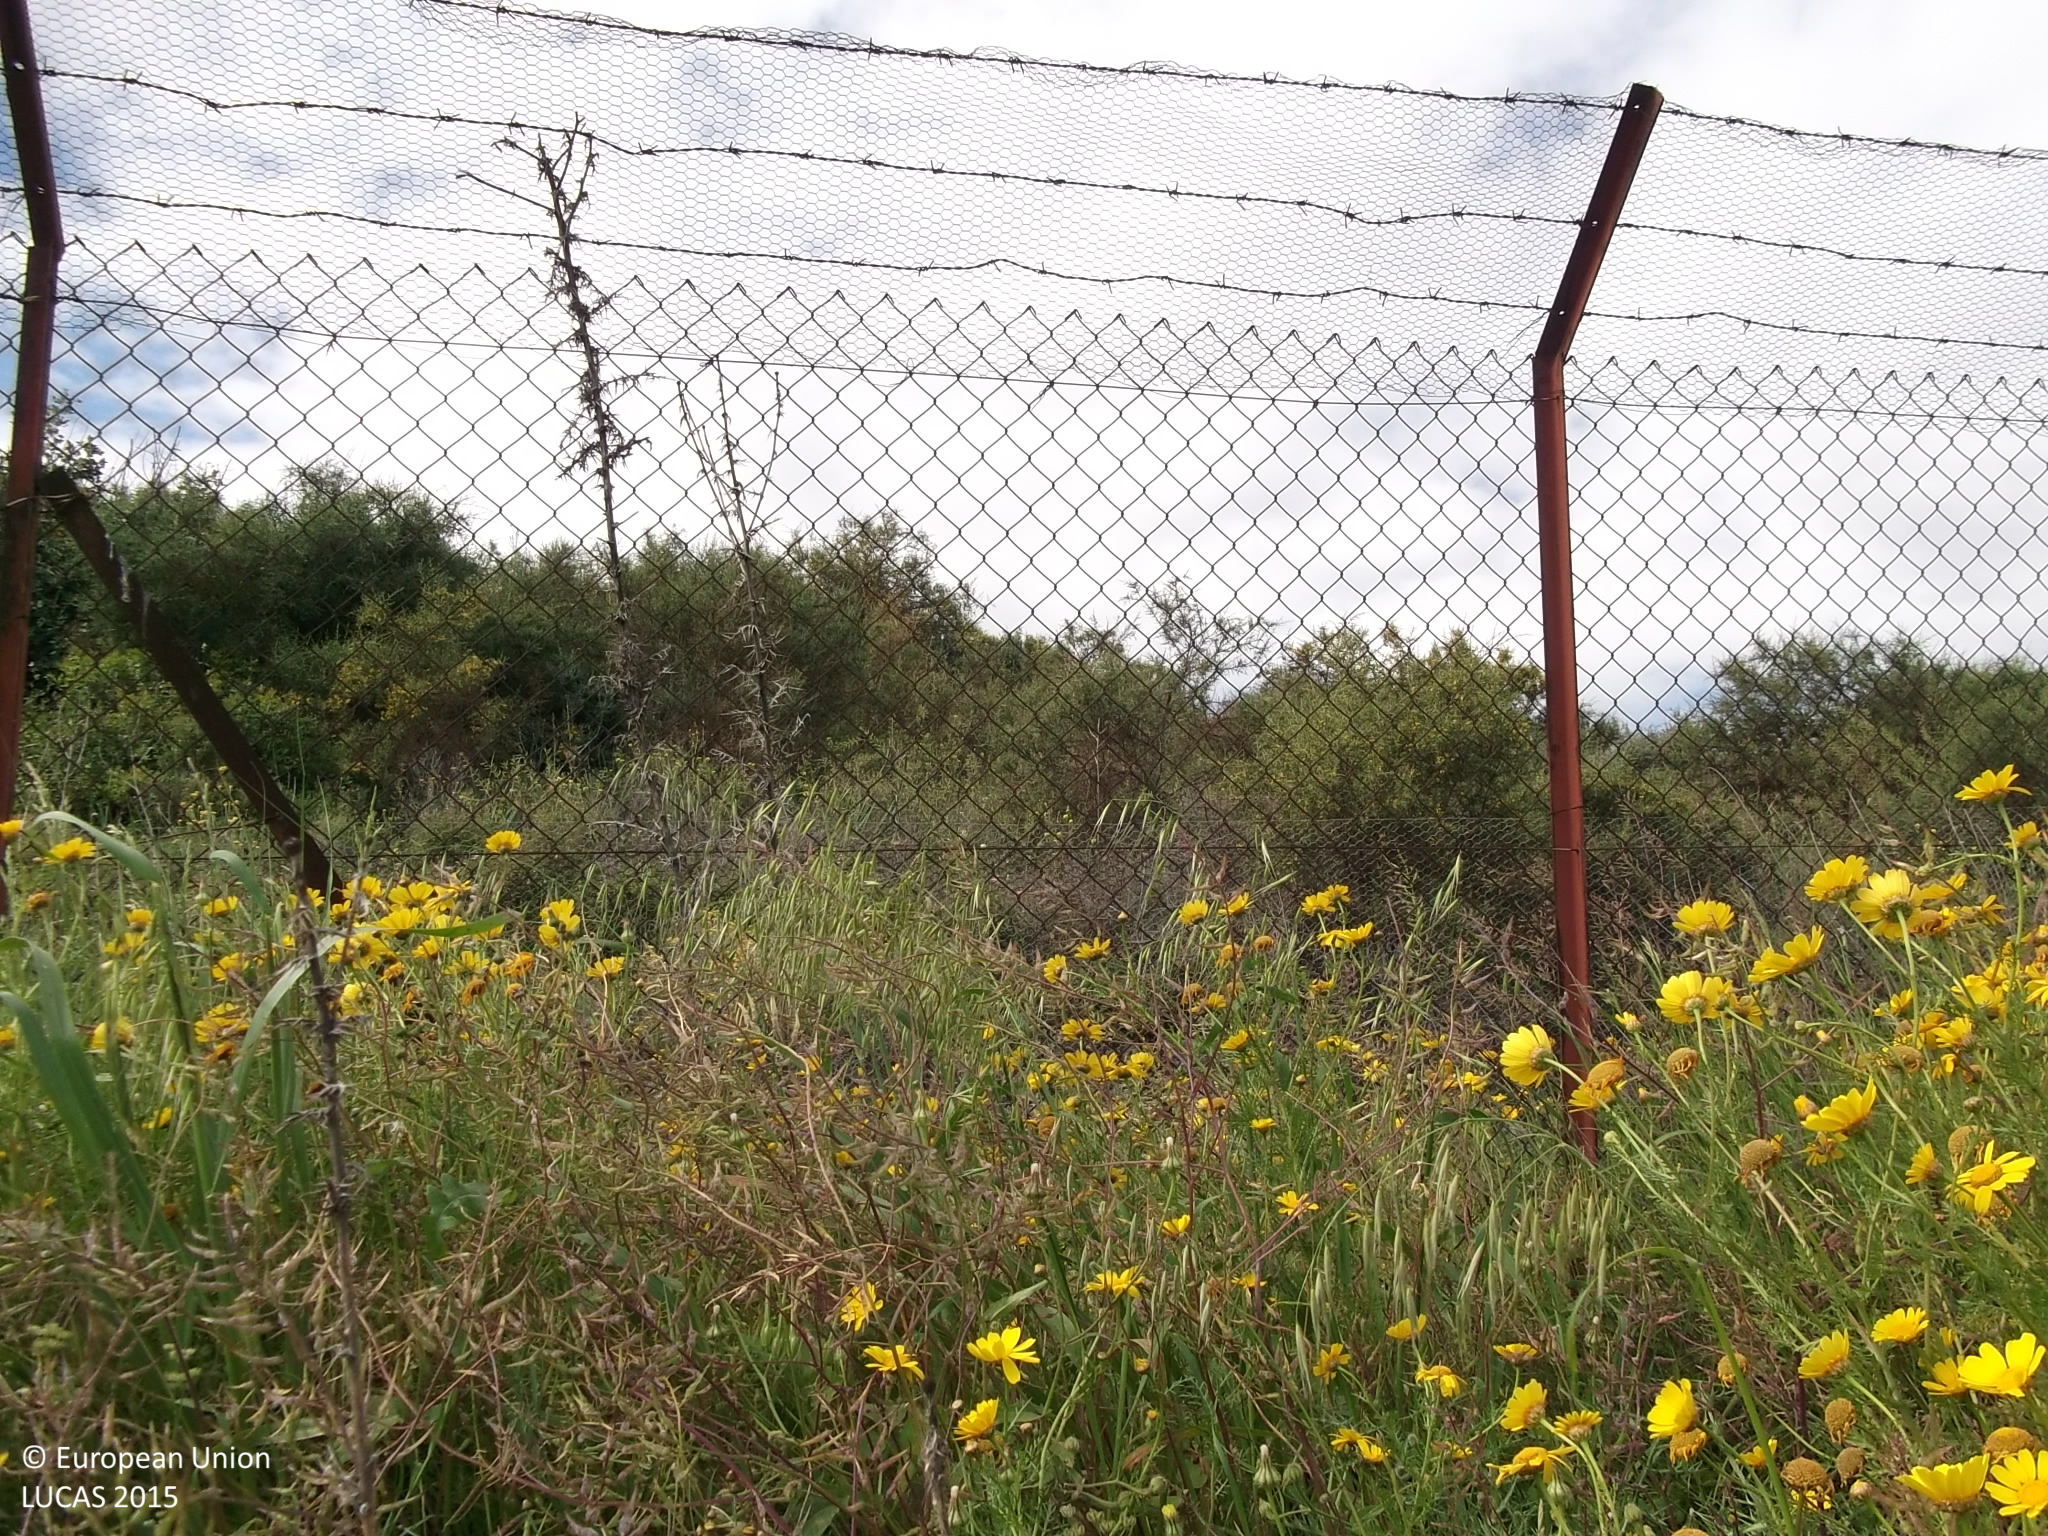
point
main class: Shrubland
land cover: Shrubland without tree cover
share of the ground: > 75 %
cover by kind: shrubs 80 %, herbaceous plants 20 %
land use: Semi-natural and natural areas not in use
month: April
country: CY
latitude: 34.8352
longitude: 33.4217
